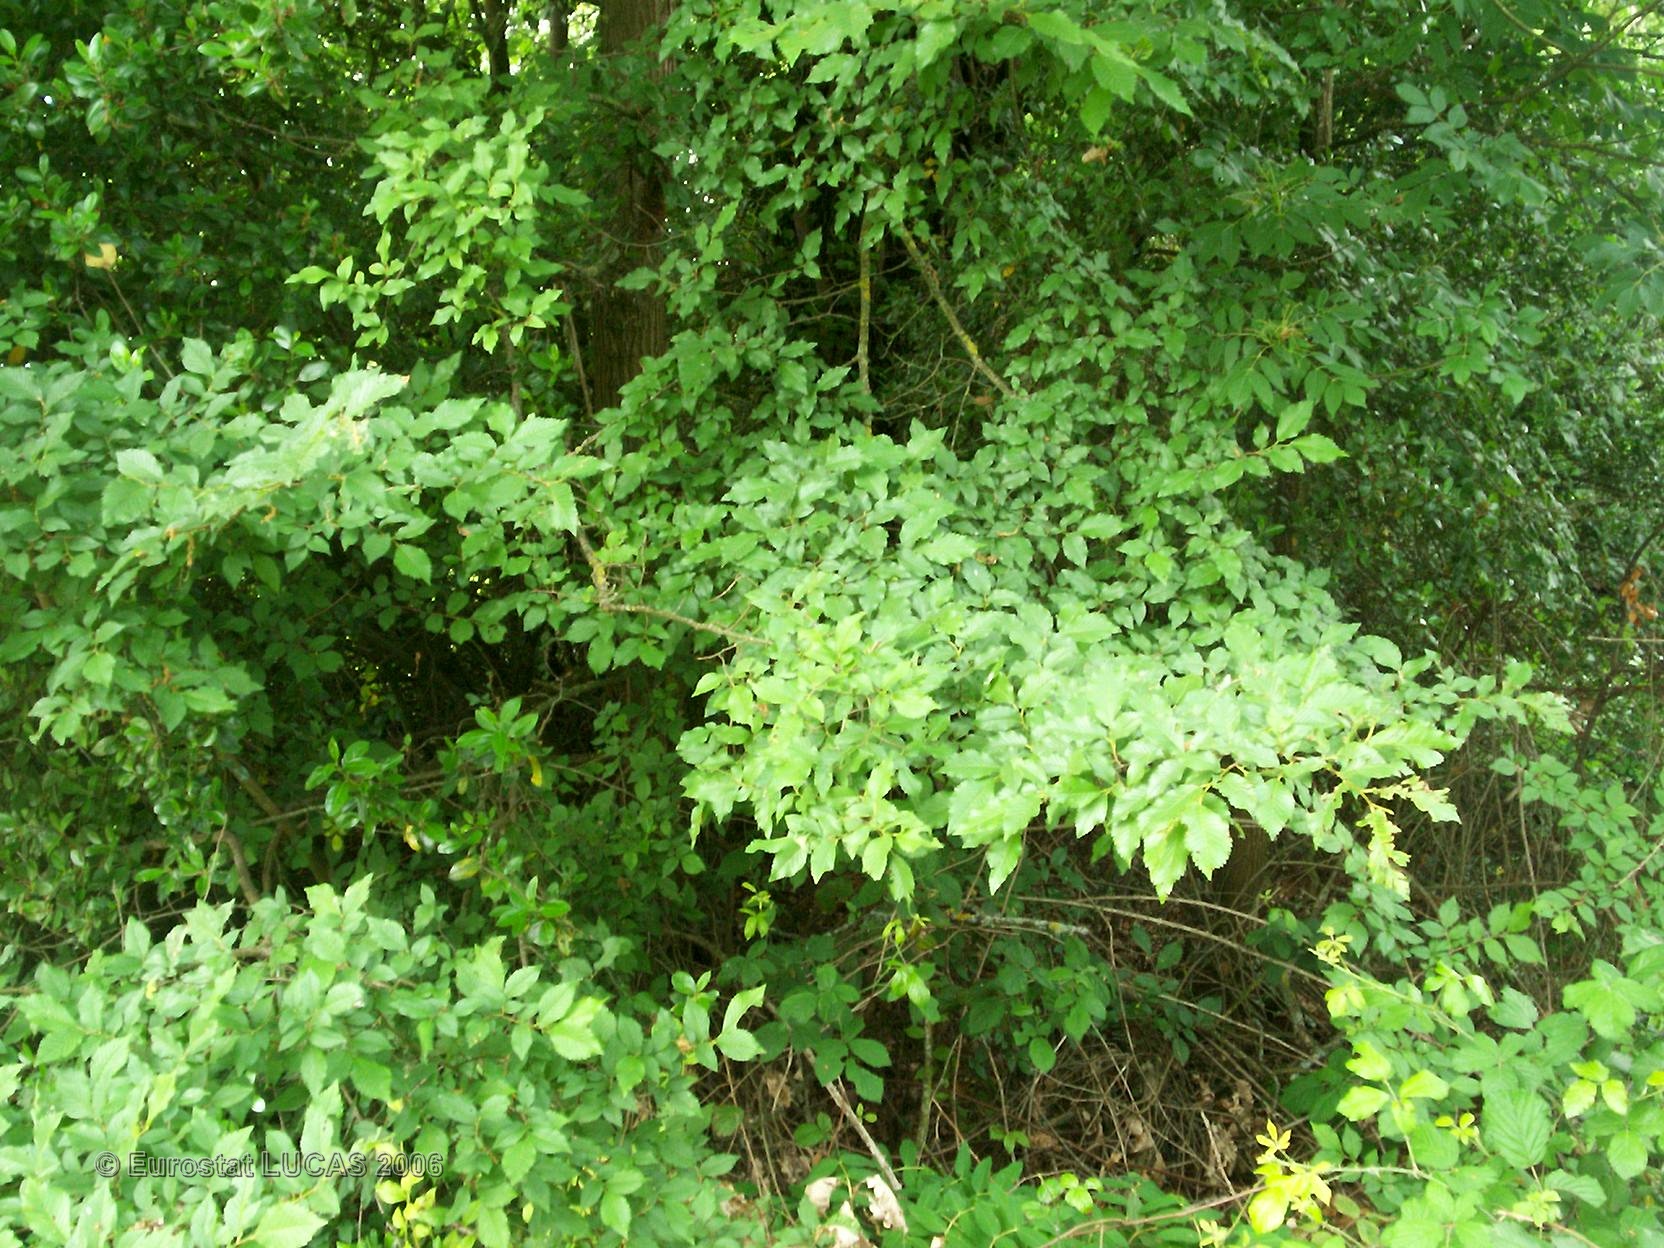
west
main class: Grassland
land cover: Grassland without tree/shrub cover
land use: Residential
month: May
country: FR
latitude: 43.6361
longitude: 0.8391
